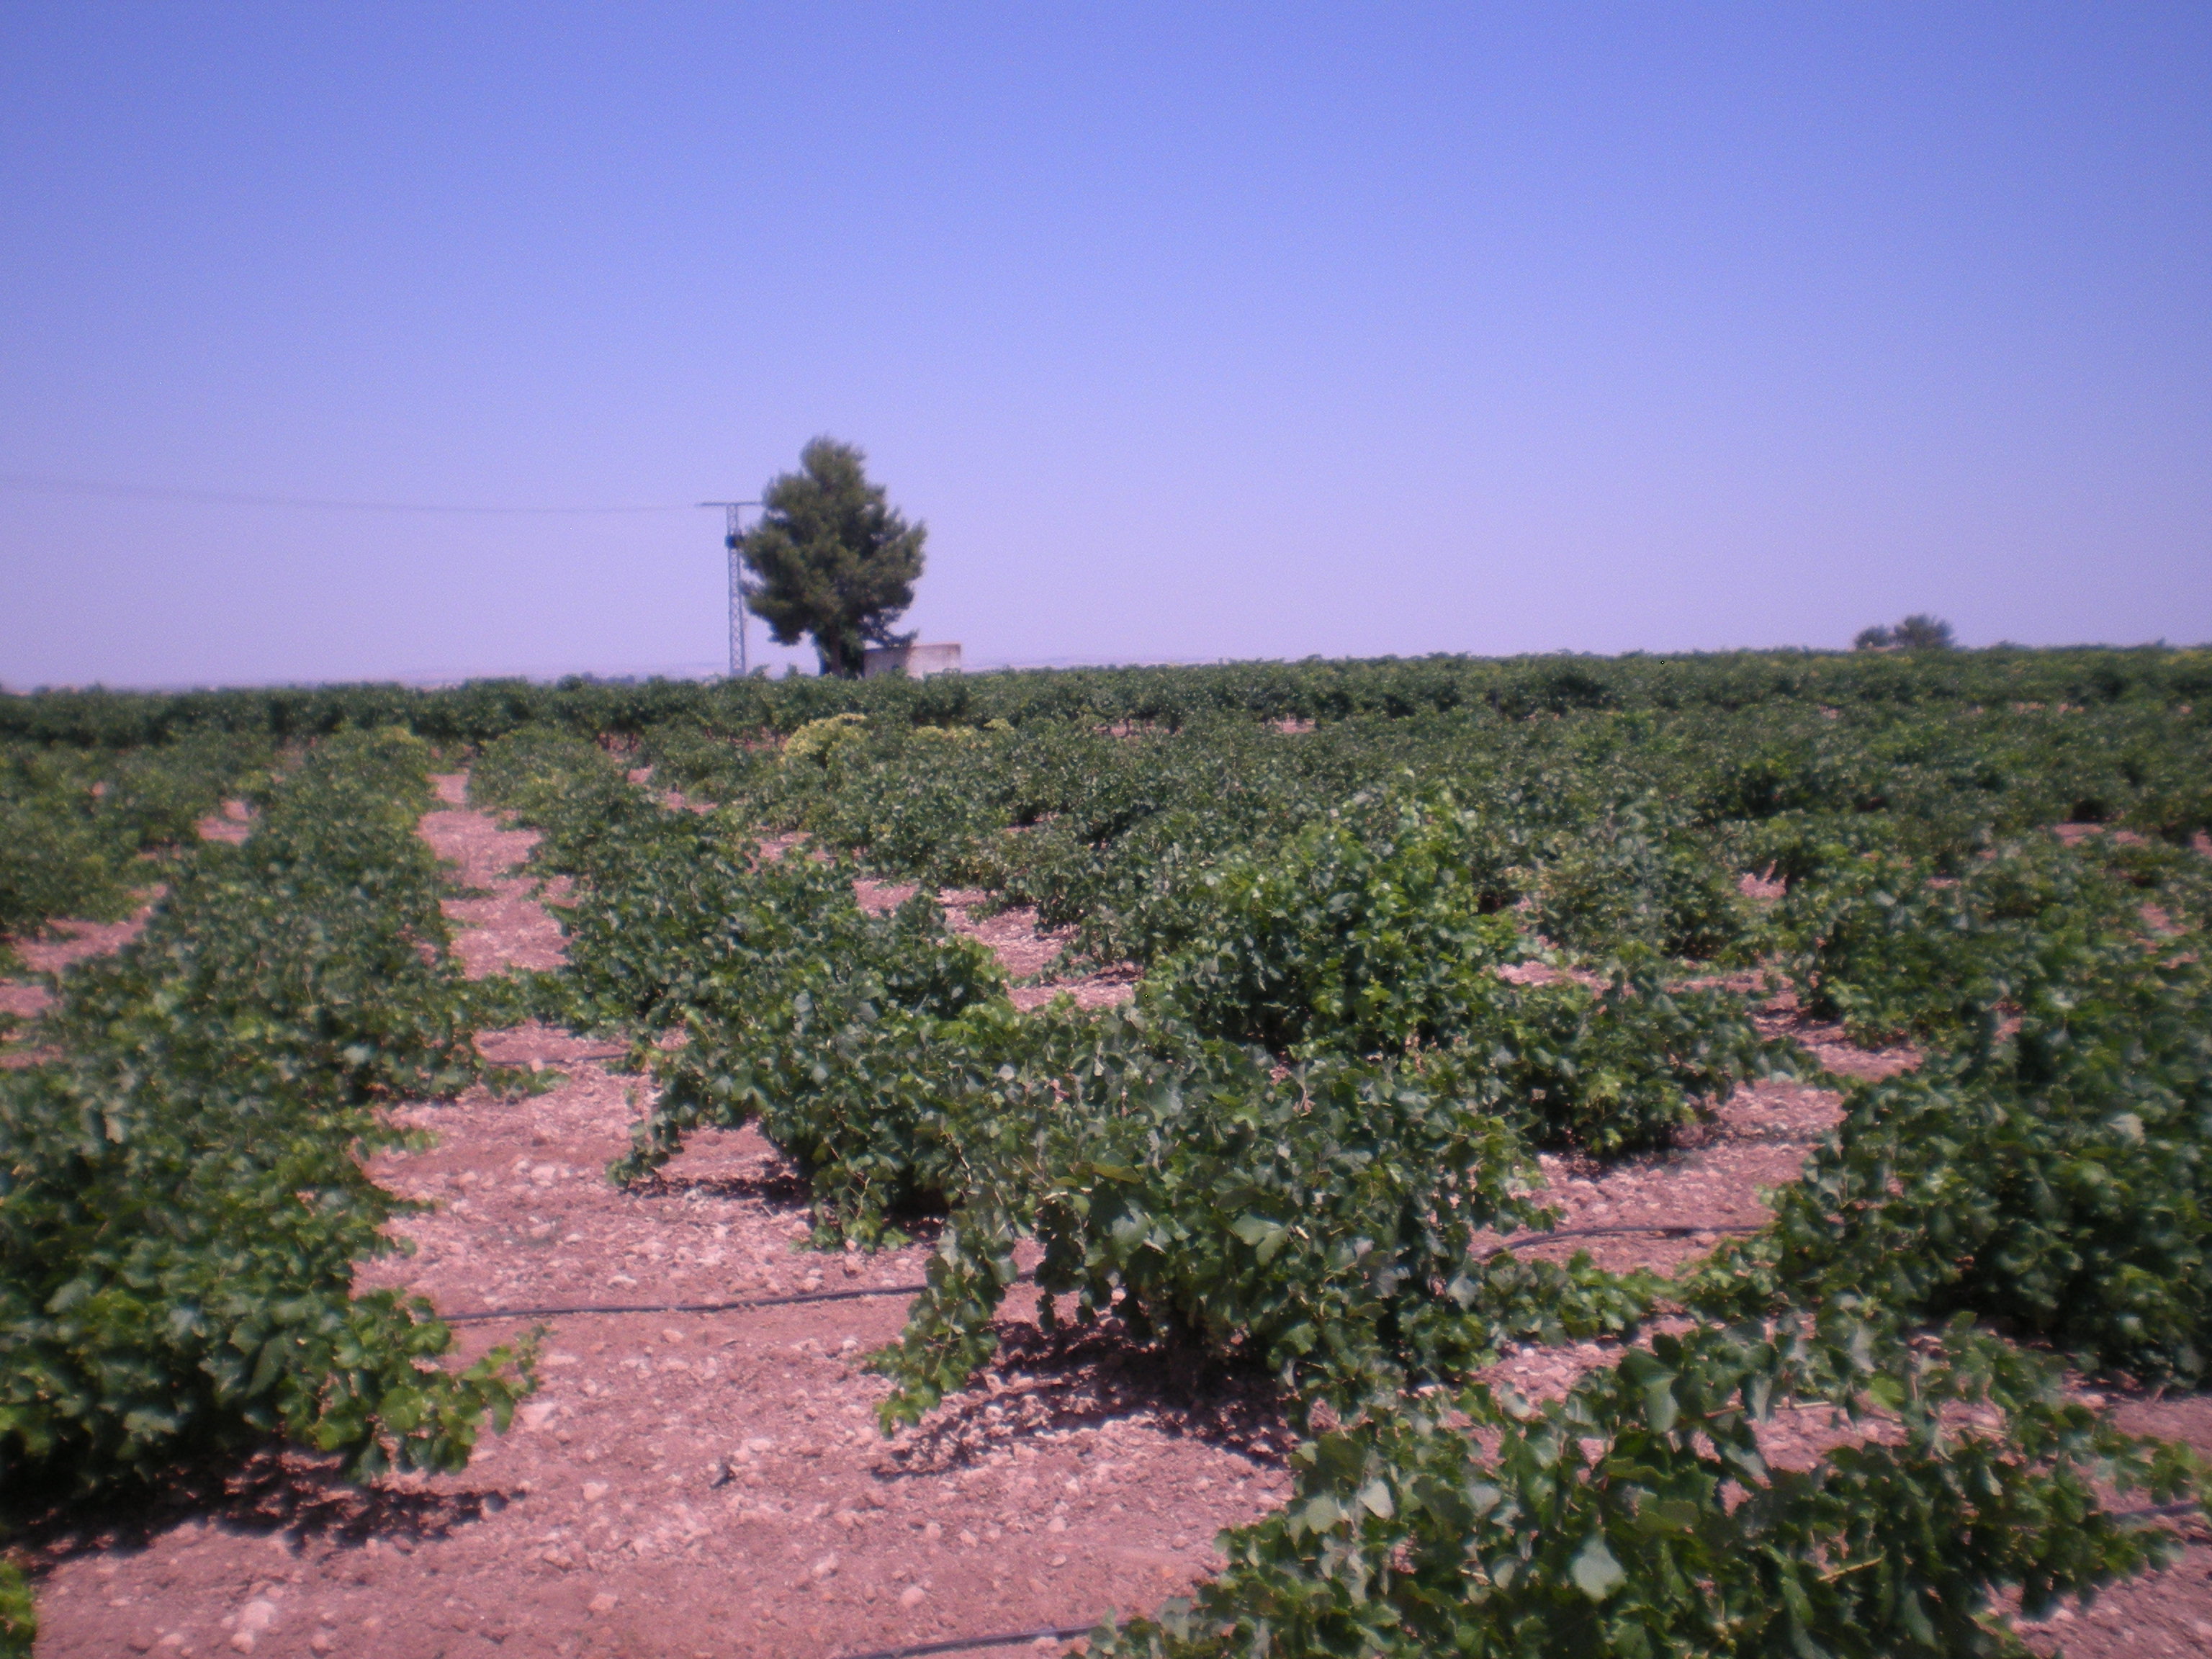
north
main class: Cropland
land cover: Vineyards
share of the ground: 25 - 50 %
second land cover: Other bare soil
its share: > 75 %
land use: Agriculture (excluding fallow land and kitchen gardens)
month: July
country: ES
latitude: 39.2569
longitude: -3.0985
